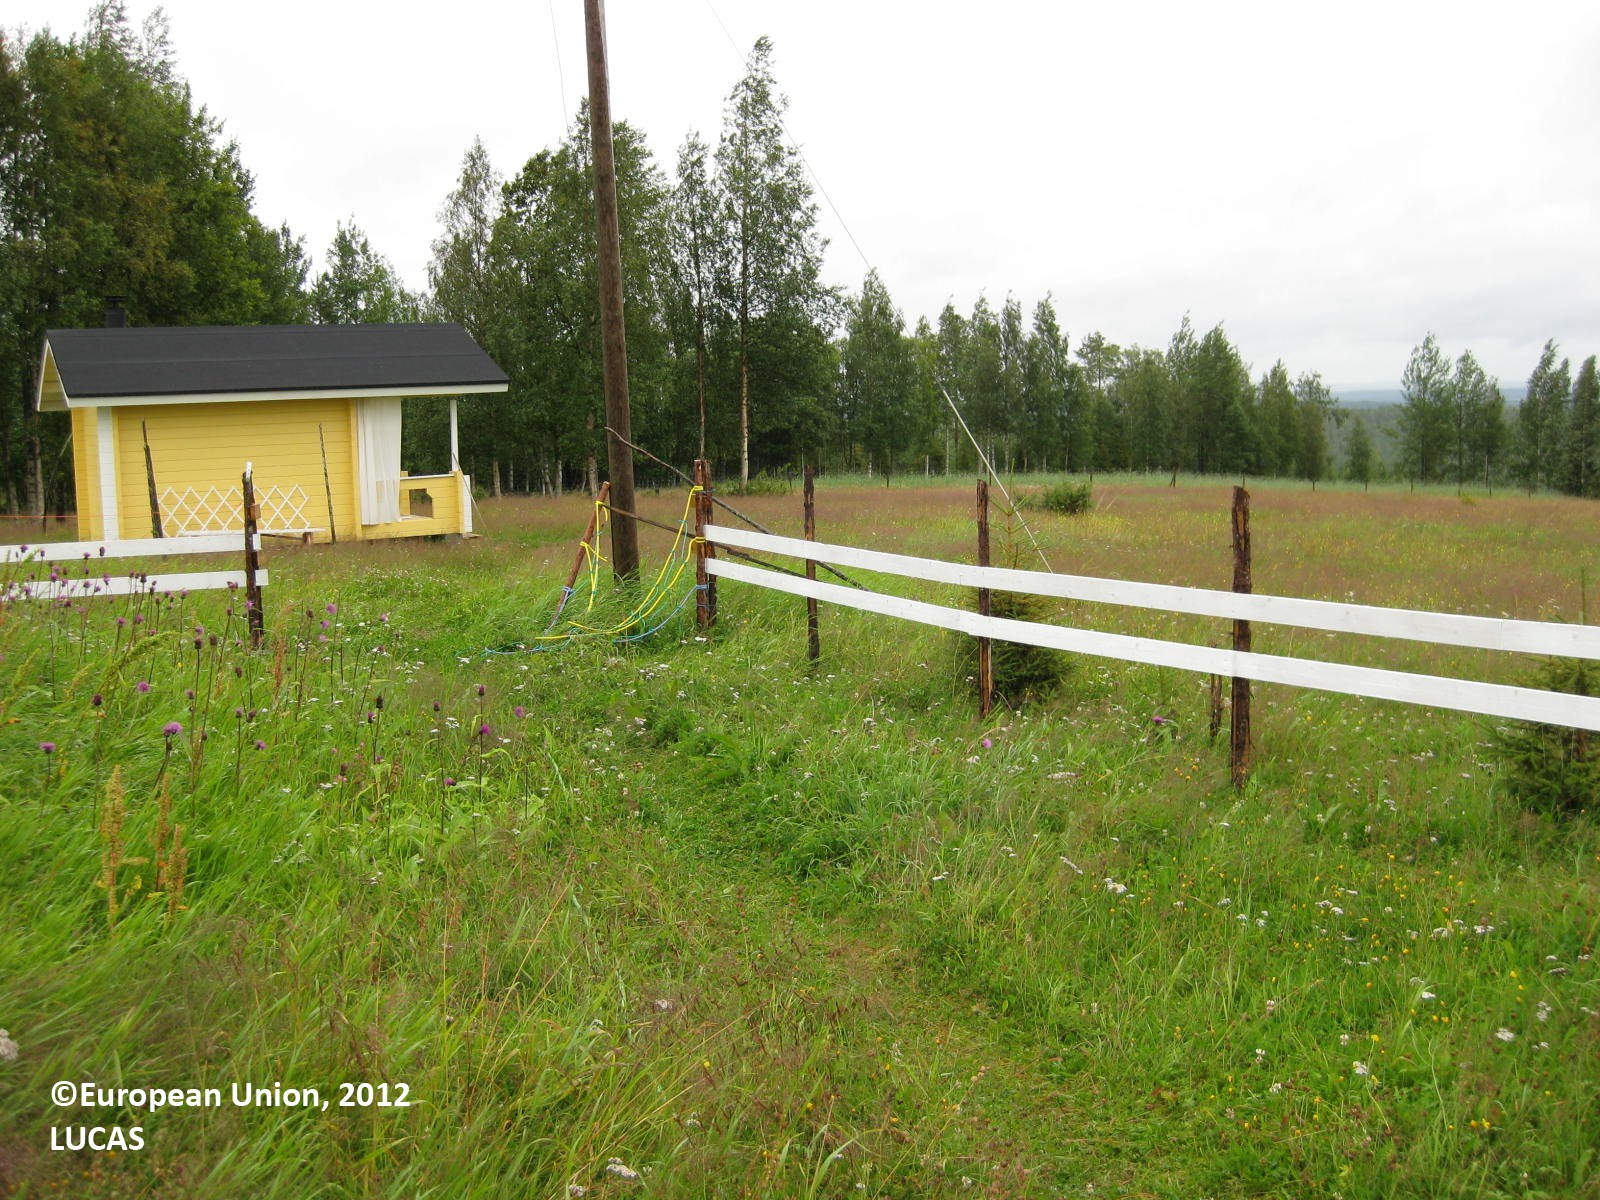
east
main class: Grassland
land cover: Grassland without tree/shrub cover
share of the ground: > 75 %
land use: Residential
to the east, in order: Grassland without tree/shrub cover; Spontaneously vegetated surfaces; Fences; Spontaneously vegetated surfaces; Artificial constructions in urban areas; Spontaneously vegetated surfaces; Broadleaved woodland; Spontaneously vegetated surfaces; Fences; Spontaneously vegetated surfaces; Fences; Broadleaved woodland; Ditches and canals; Dry stone walls; Broadleaved woodland; Spruce dominated mixed woodland; Pine dominated mixed woodland; Ditches and canals; Pine dominated mixed woodland; Ditches and canals; Pine dominated mixed woodland; Ditches and canals; Pine dominated mixed woodland; Ditches and canals; Pine dominated mixed woodland; Ditches and canals; Pine dominated mixed woodland; Ditches and canals; Pine dominated mixed woodland; Ditches and canals; Pine dominated mixed woodland; Ditches and canals; Pine dominated mixed woodland; Ditches and canals; Pine dominated mixed woodland; Ditches and canals
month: August
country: FI
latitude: 65.9679
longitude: 28.1658
